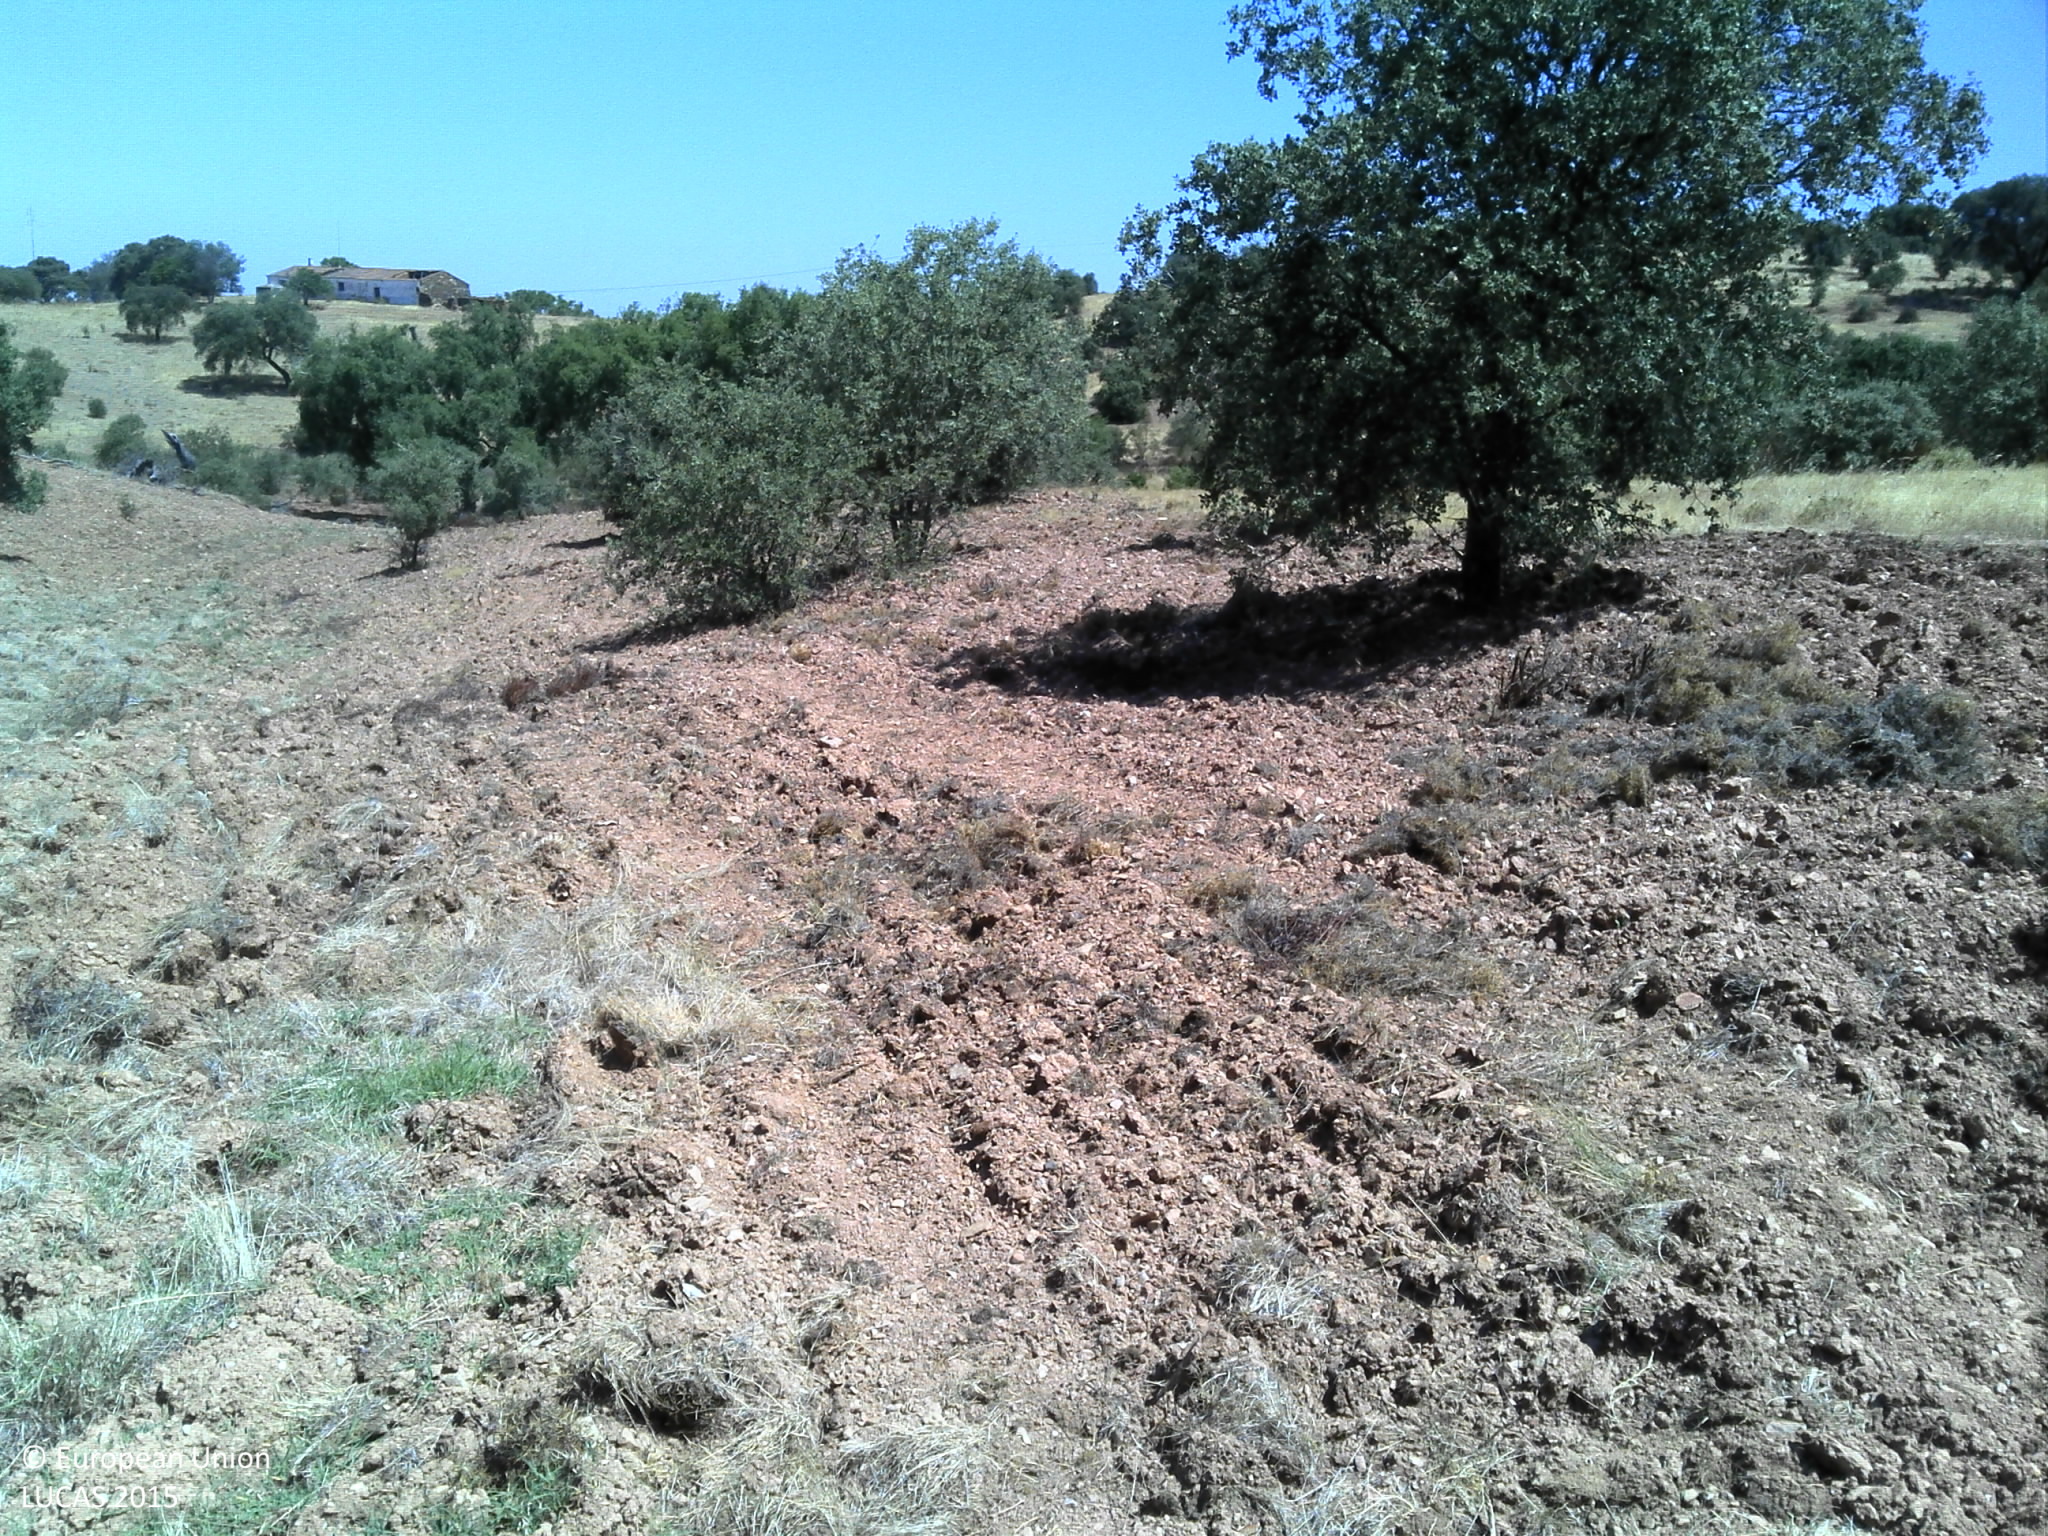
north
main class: Grassland
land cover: Grassland with sparse tree/shrub cover
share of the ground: 10 - 25 %
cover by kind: unconsolidated bare surface 75 %, herbaceous plants 20 %, broadleaved forest trees 5 %
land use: Agriculture (excluding fallow land and kitchen gardens)
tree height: < 5 m
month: June
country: PT
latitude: 37.8481
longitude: -7.5063
